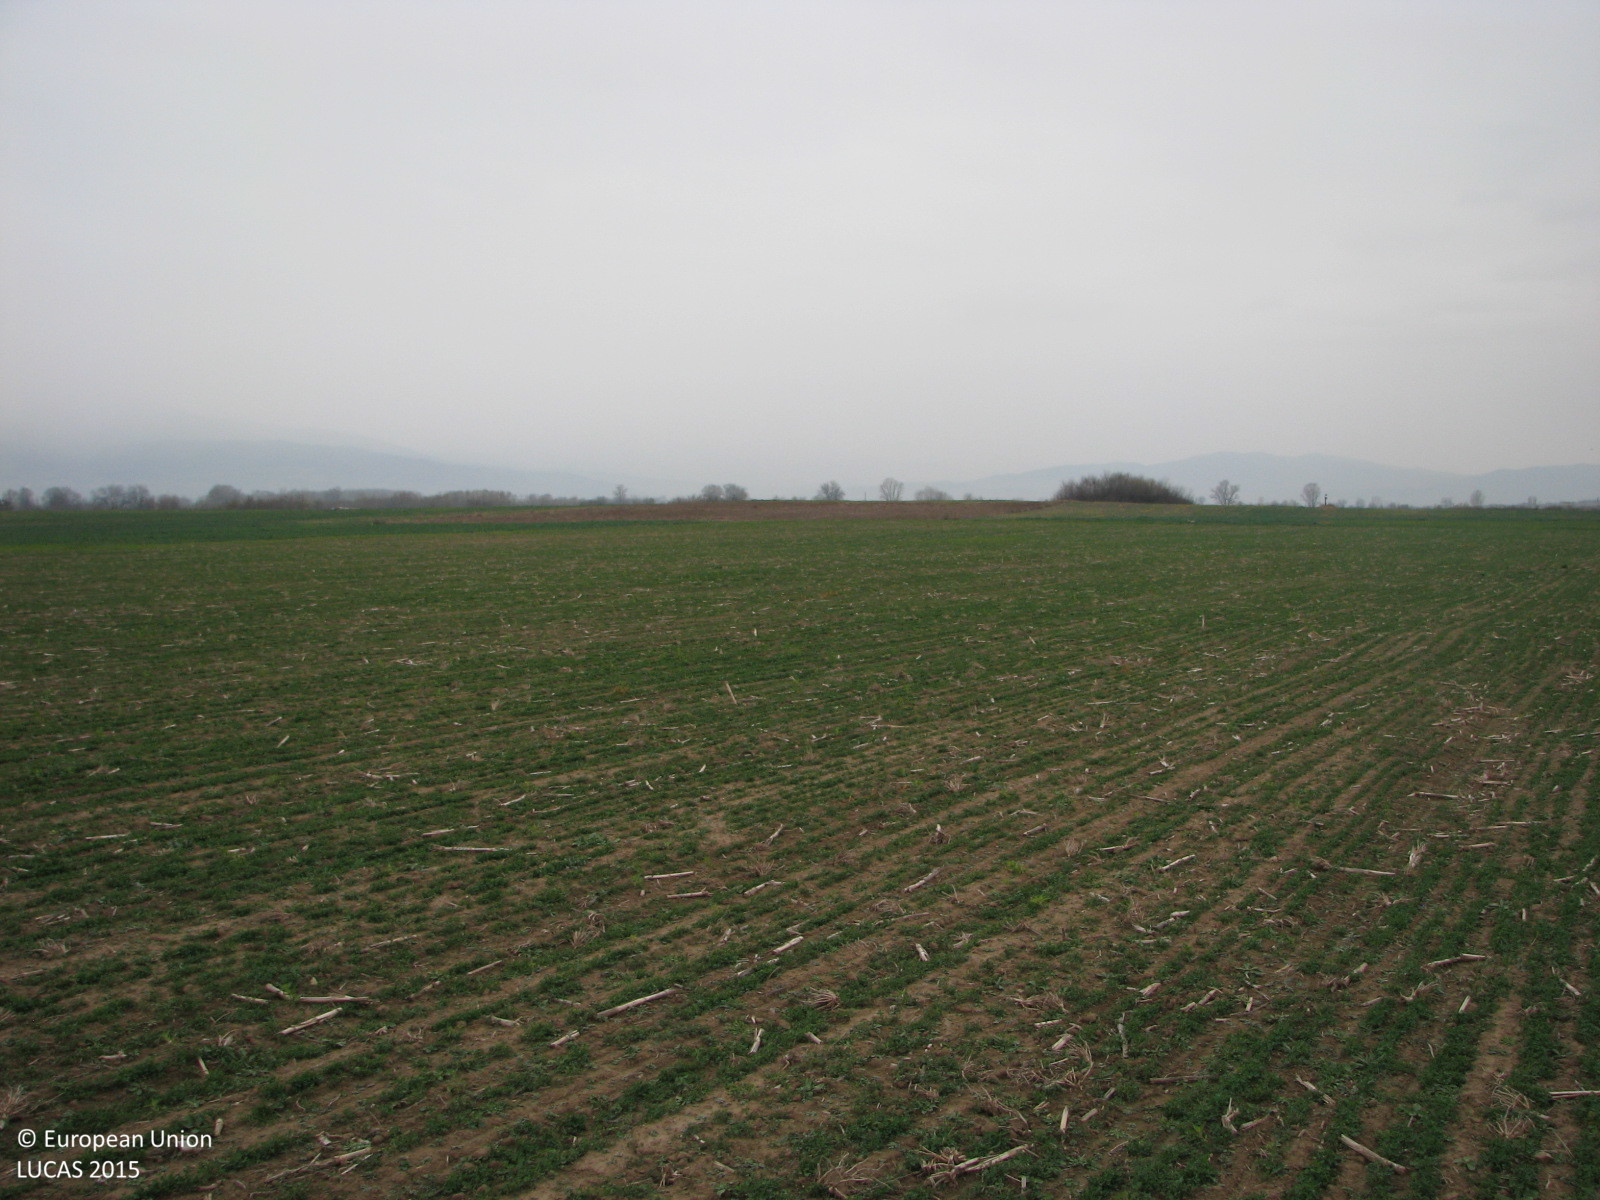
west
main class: Cropland
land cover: Maize
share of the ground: < 10 %
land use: Agriculture (excluding fallow land and kitchen gardens)
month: December
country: BG
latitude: 42.2325
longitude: 24.2079
